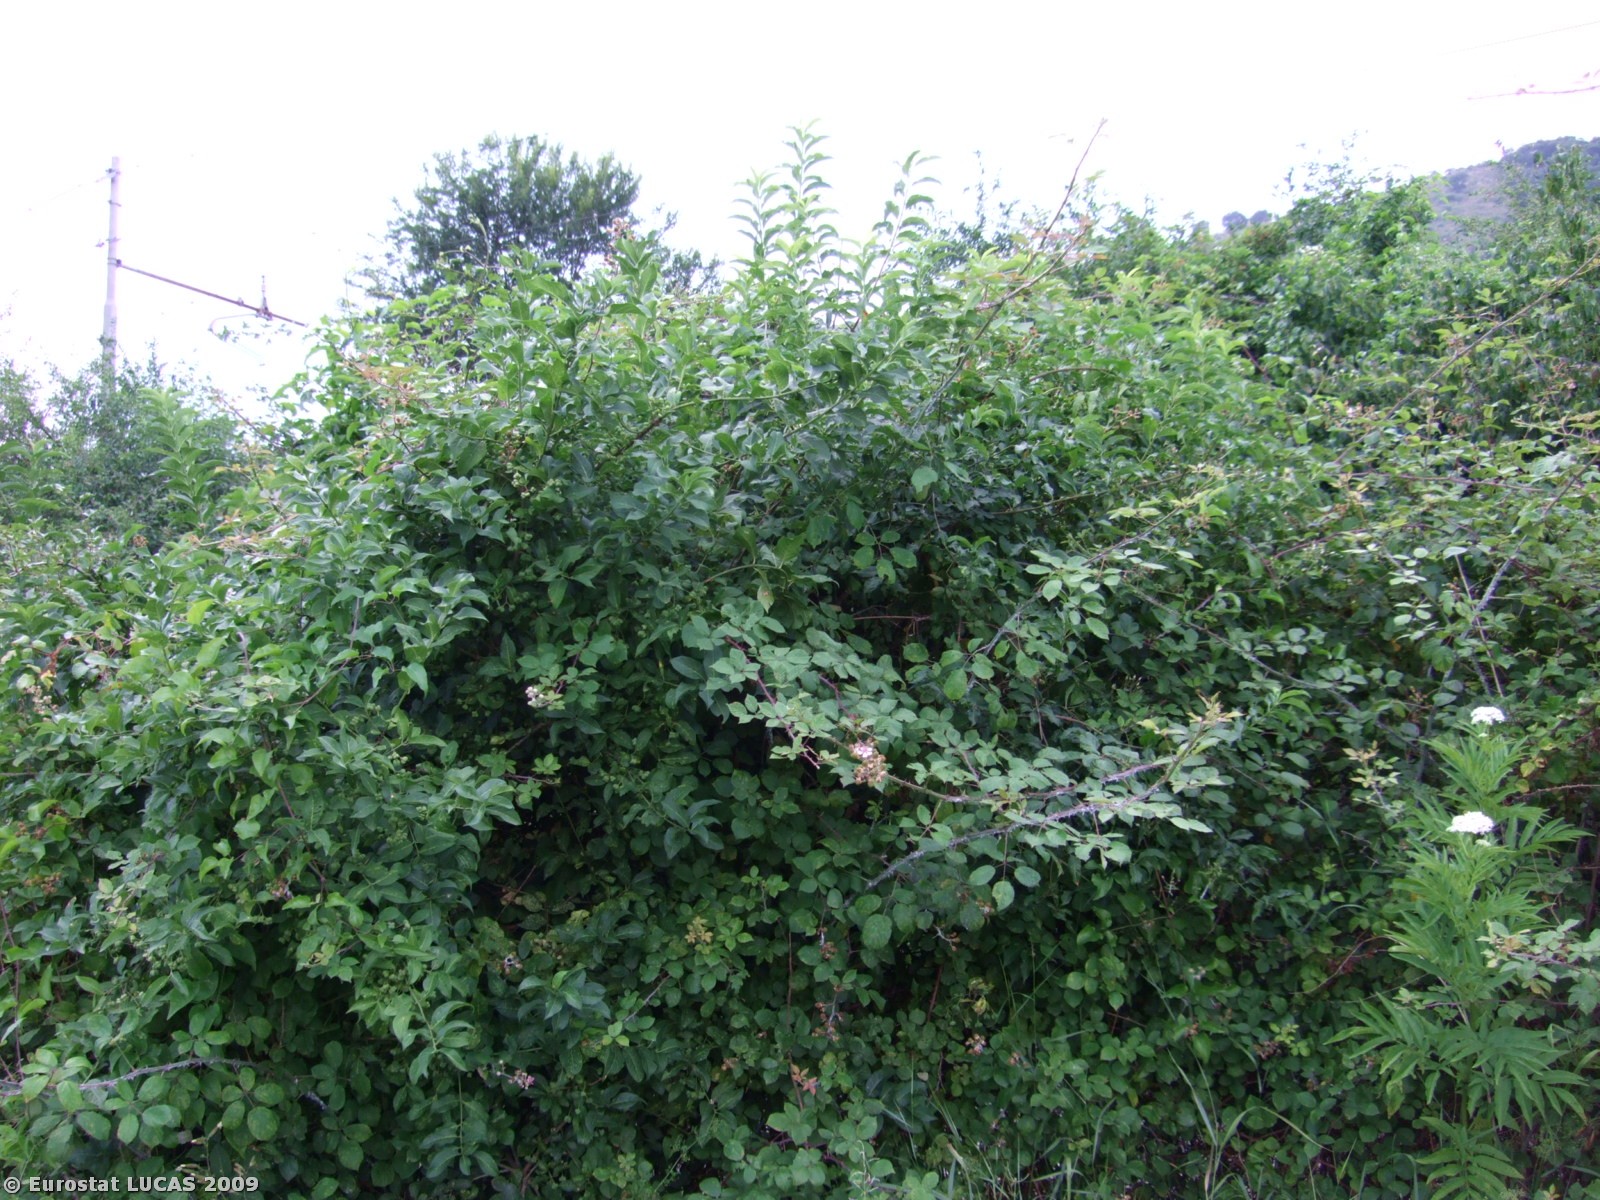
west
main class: Cropland
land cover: Lucerne
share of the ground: > 75 %
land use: Agriculture (excluding fallow land and kitchen gardens)
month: July
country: IT
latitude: 41.9639
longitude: 12.8253
